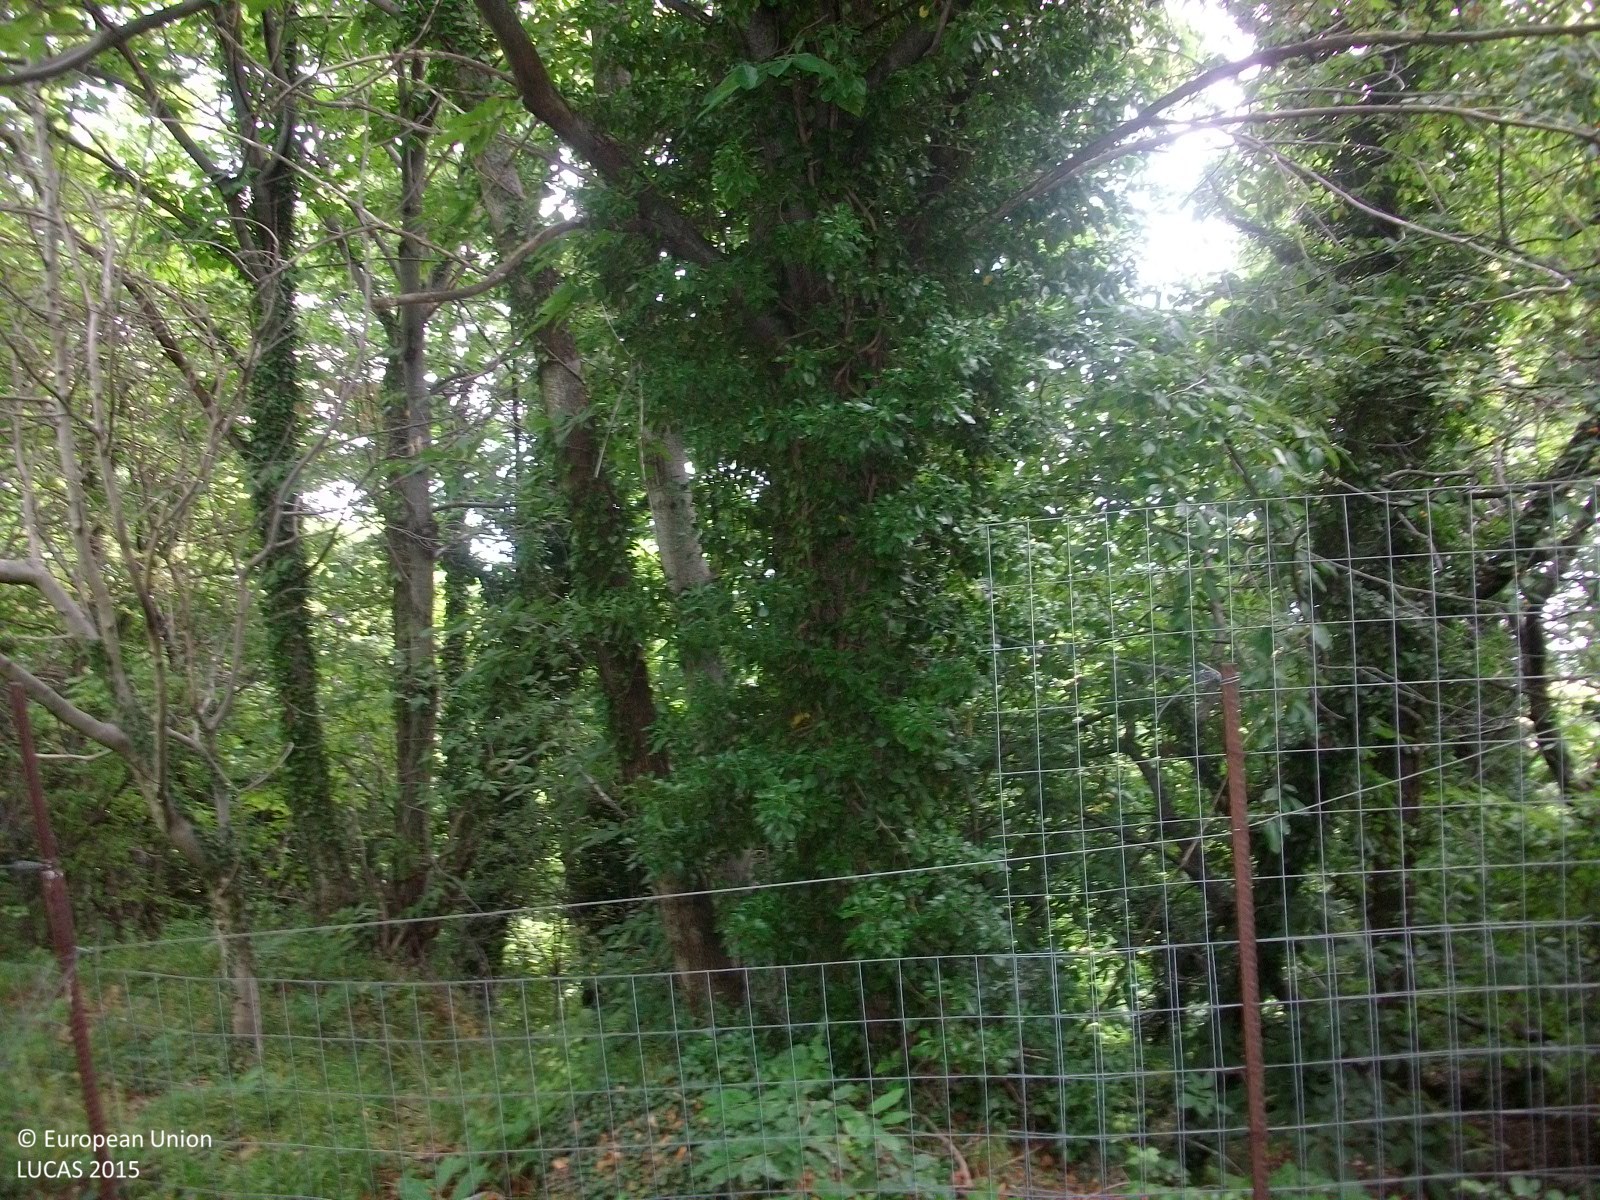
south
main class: Woodland
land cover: Broadleaved woodland
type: thermophilous deciduous forest
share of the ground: > 75 %
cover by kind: broadleaved forest trees 100 %
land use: Semi-natural and natural areas not in use
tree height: > 5 m
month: June
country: GR
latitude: 39.3428
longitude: 23.1393
